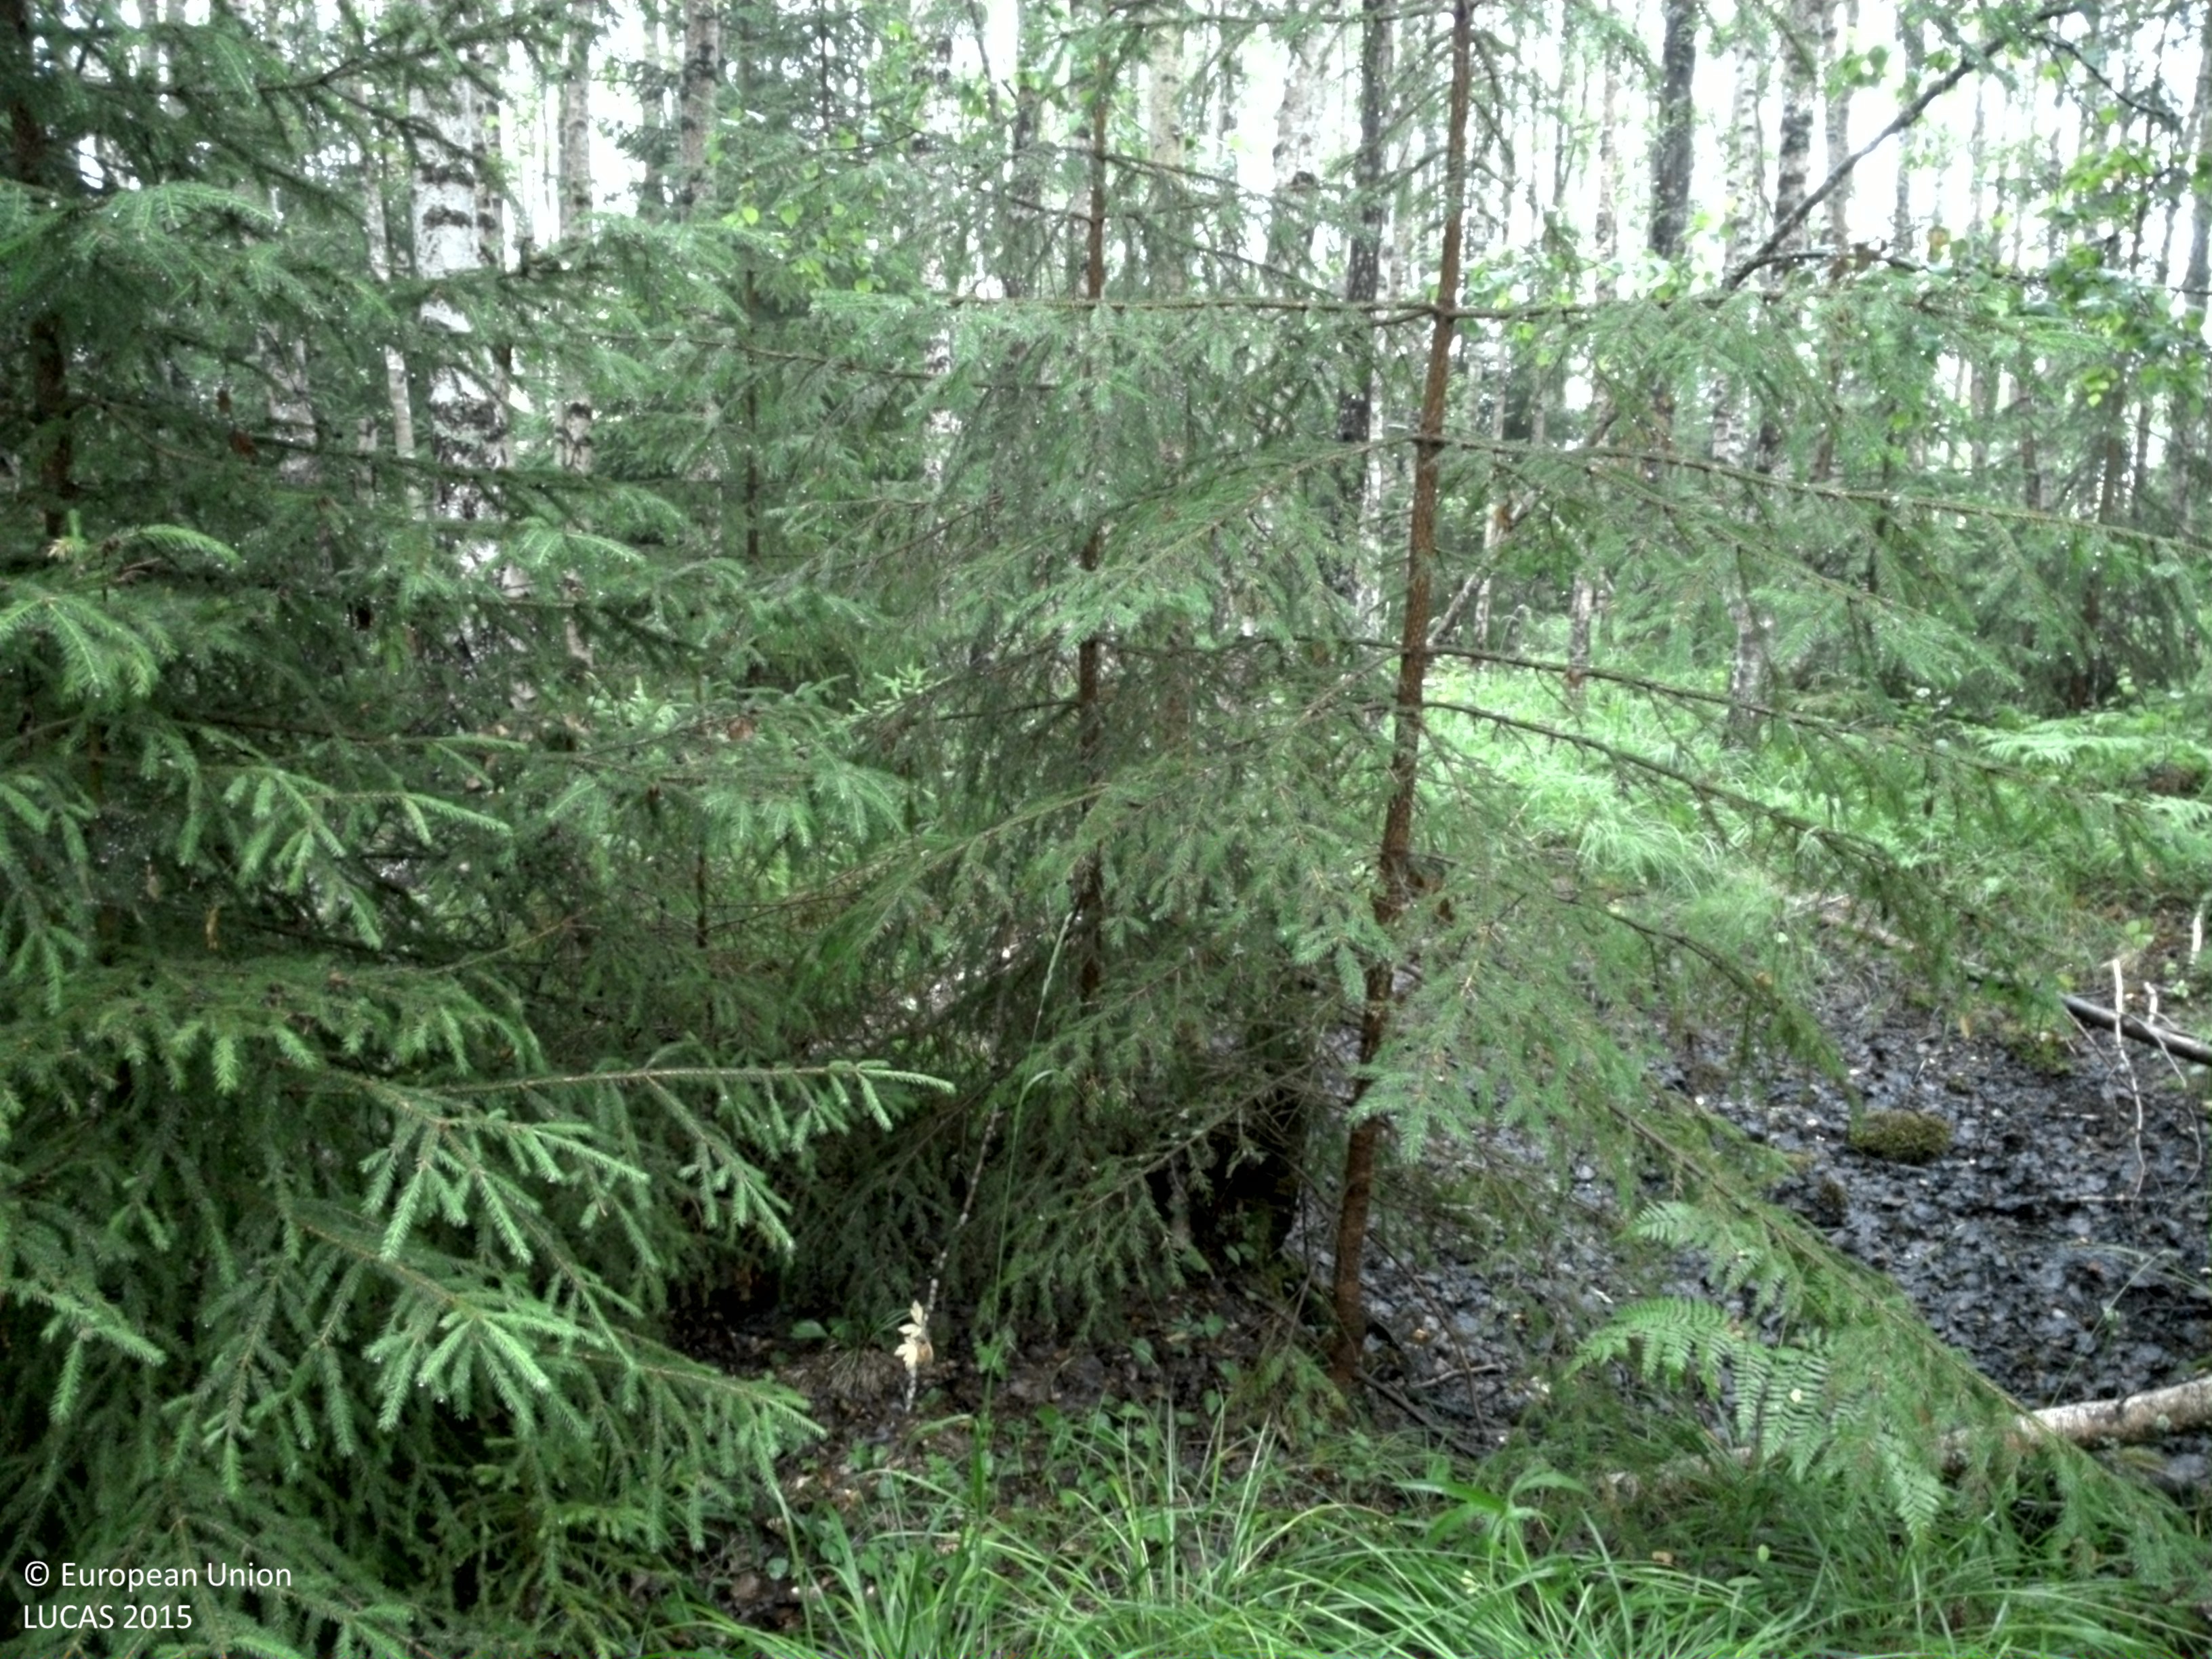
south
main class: Woodland
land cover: Other mixed woodland
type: boreal forest
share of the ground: > 75 %
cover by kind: broadleaved forest trees 50 %, coniferous forest trees 40 %, herbaceous plants 10 %
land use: Forestry
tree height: > 5 m
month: July
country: SE
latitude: 60.0871
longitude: 17.2008
